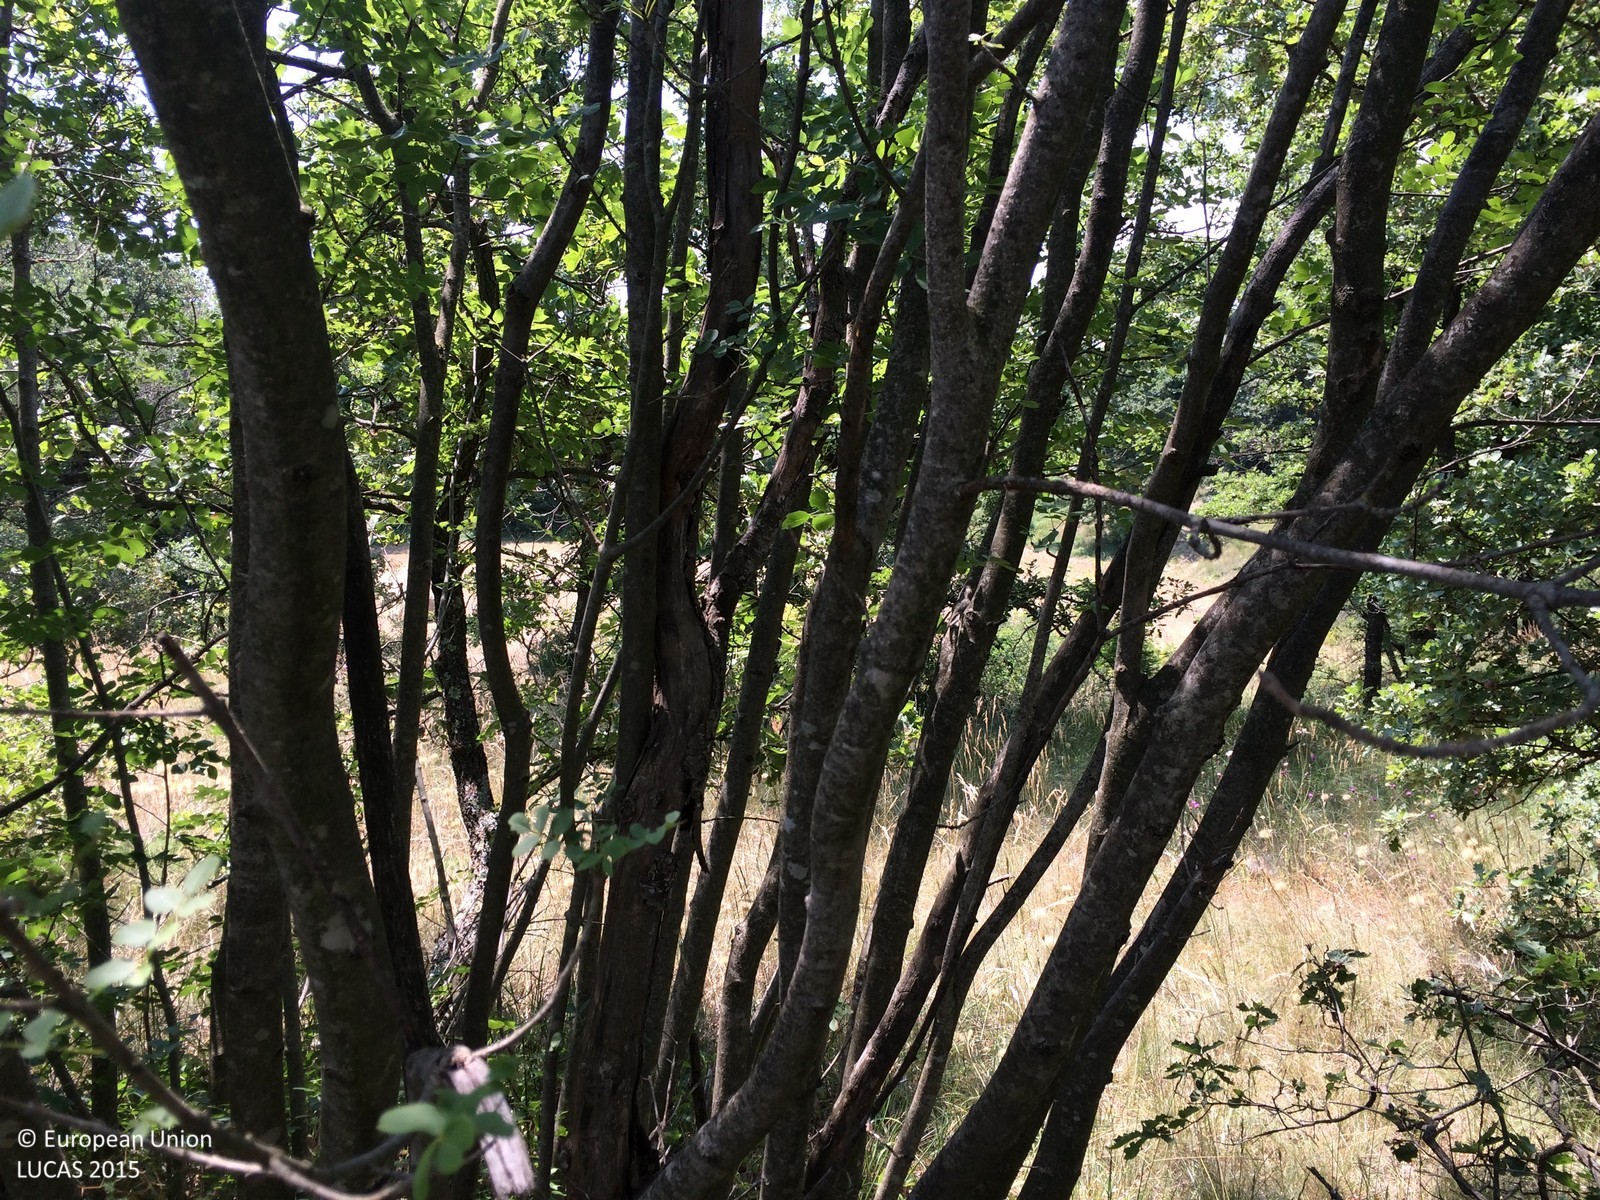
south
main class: Grassland
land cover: Grassland with sparse tree/shrub cover
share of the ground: 50 - 75 %
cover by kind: herbaceous plants 90 %, broadleaved forest trees 5 %, shrubs 5 %
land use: Semi-natural and natural areas not in use
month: June
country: HR
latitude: 45.0367
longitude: 13.8661
